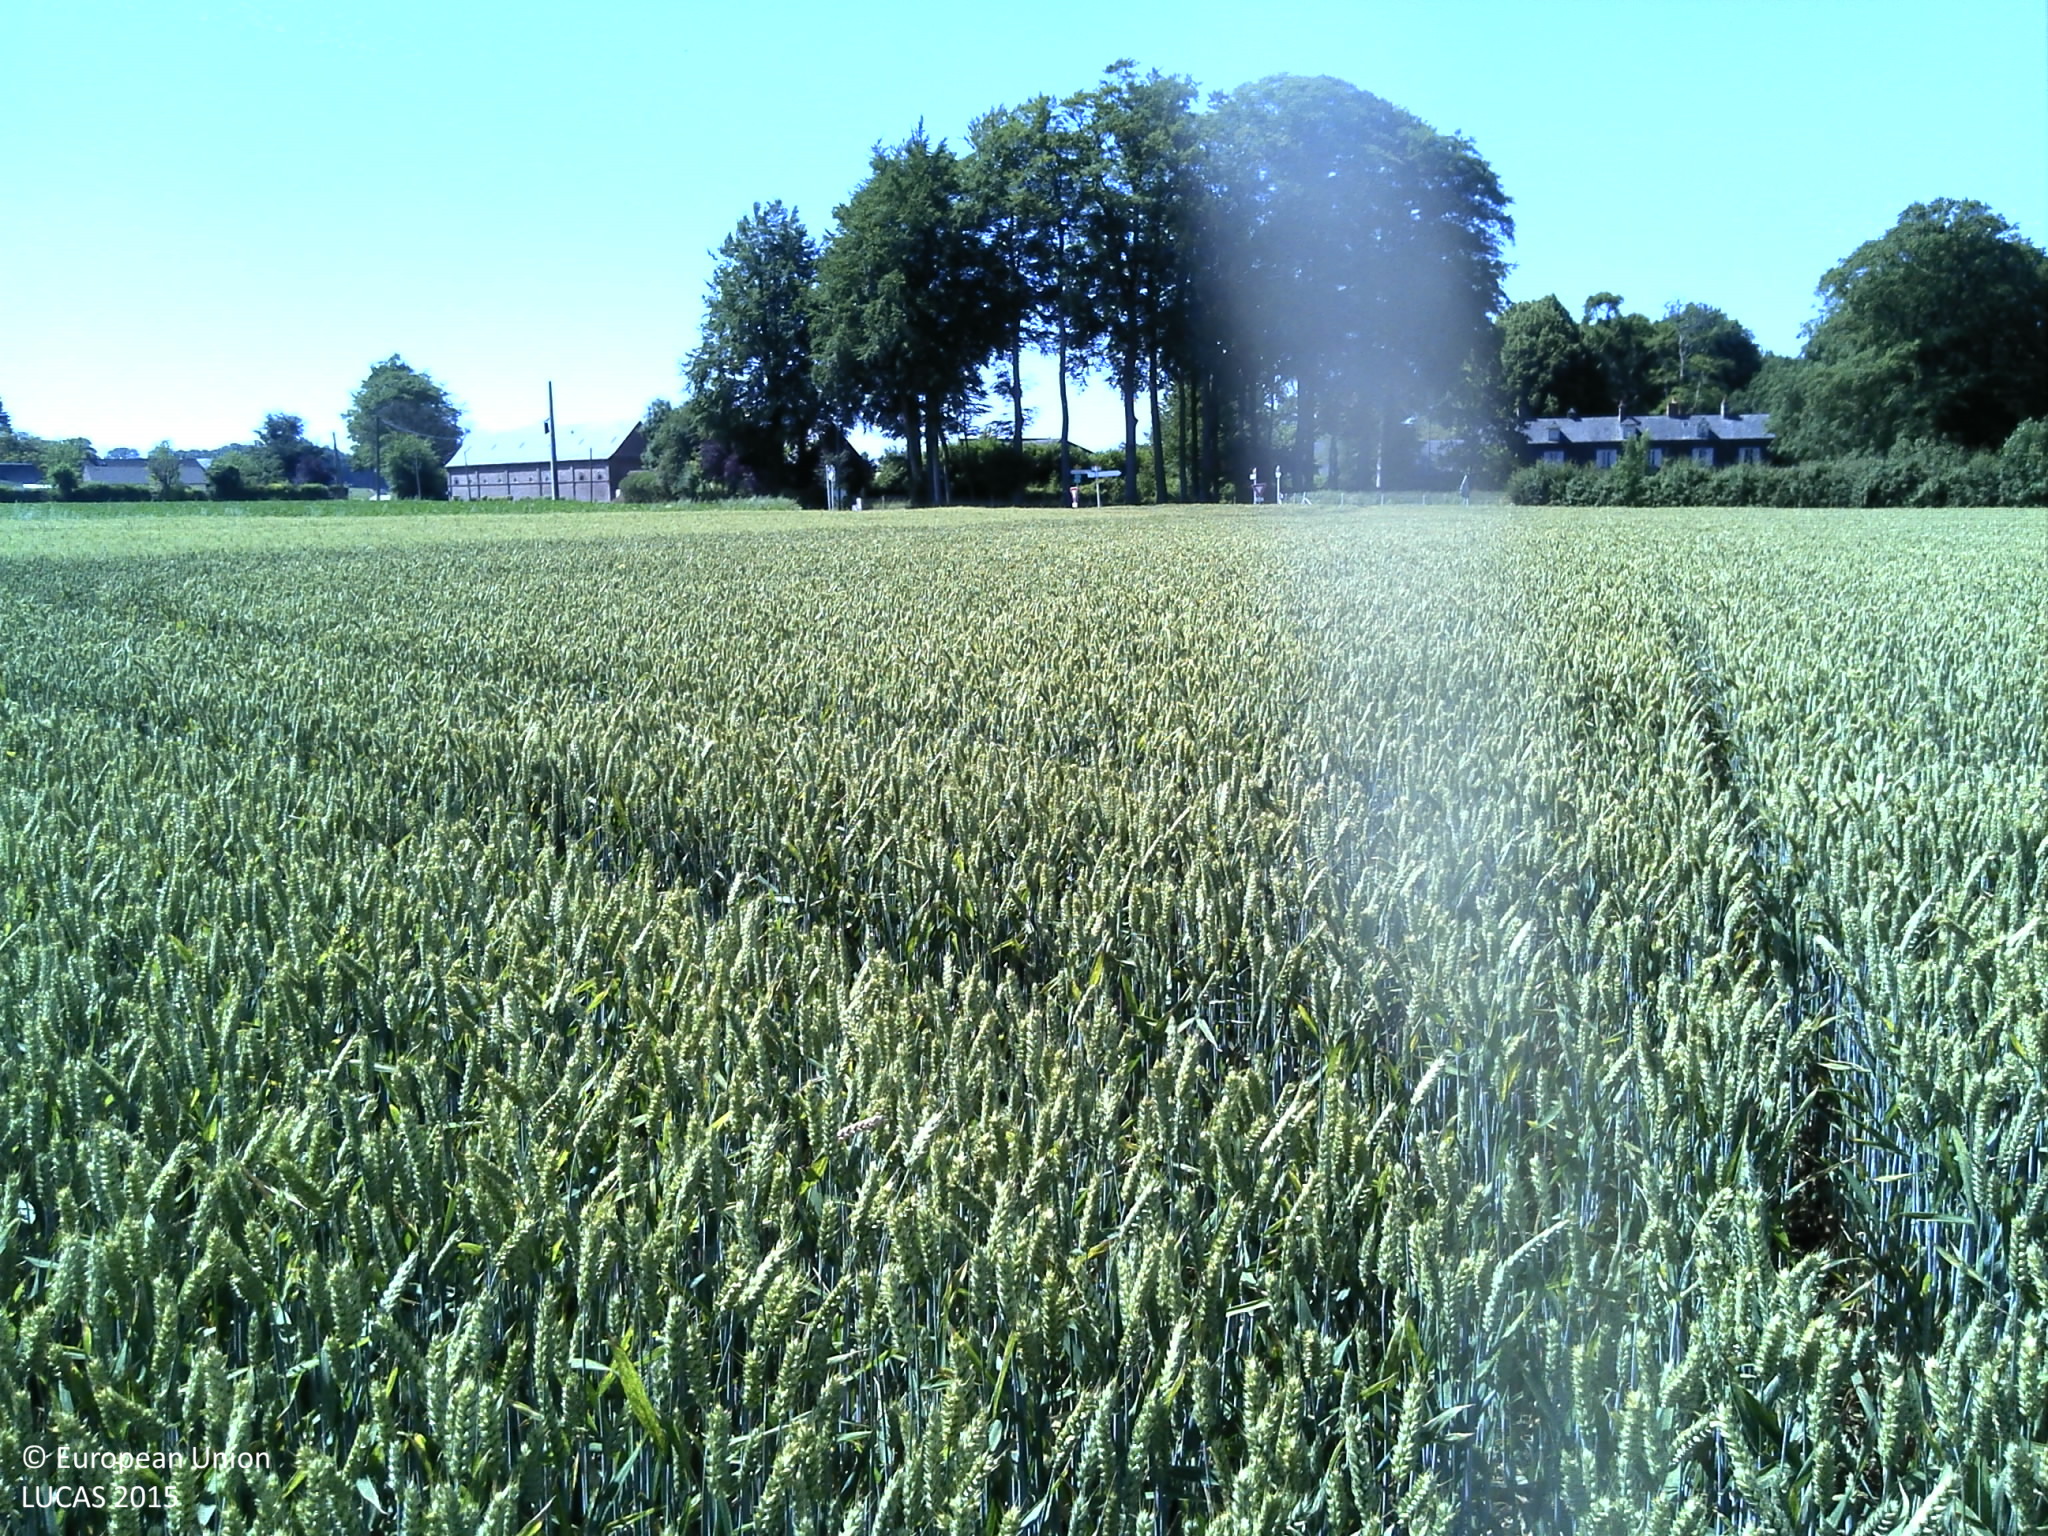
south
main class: Cropland
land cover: Common wheat
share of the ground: > 75 %
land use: Agriculture (excluding fallow land and kitchen gardens)
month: June
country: FR
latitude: 49.8464
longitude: 1.0075
